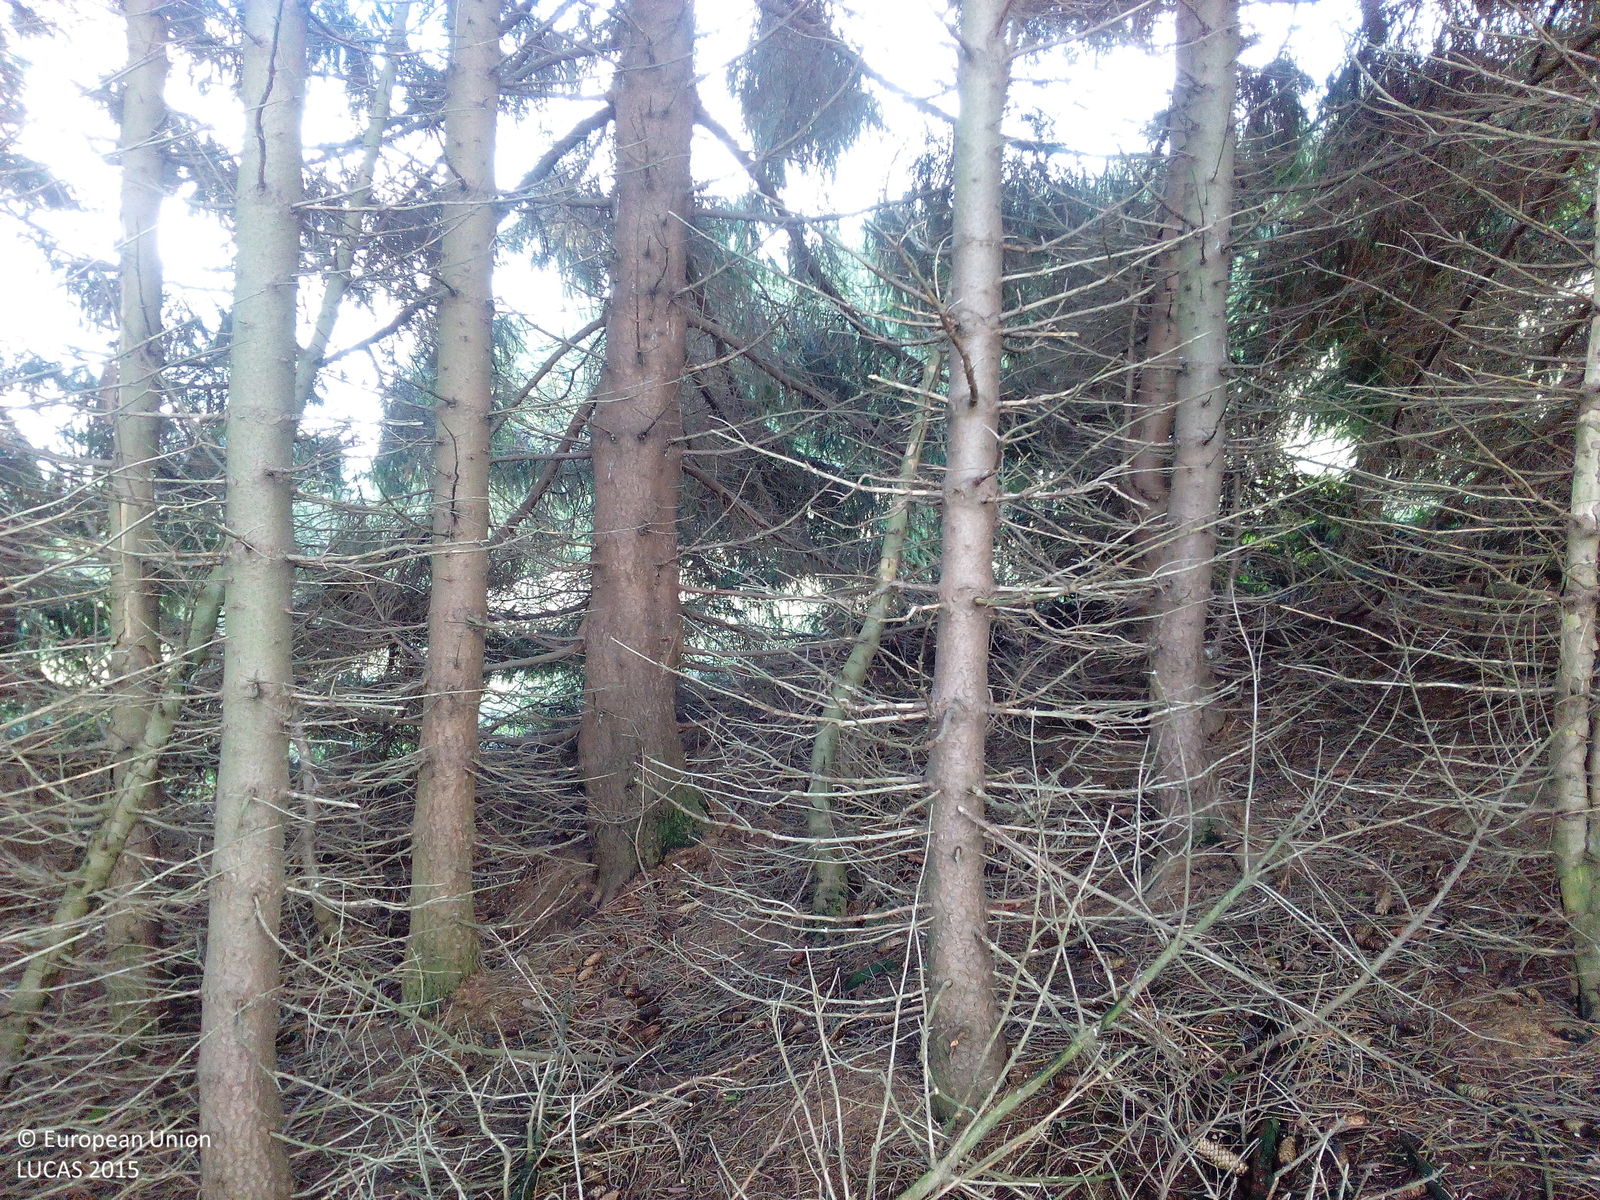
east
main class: Woodland
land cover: Spruce dominated coniferous woodland
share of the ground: > 75 %
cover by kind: coniferous forest trees 80 %, consolidated bare surface 15 %, lichens and mosses 5 %
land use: Forestry
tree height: > 5 m
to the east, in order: Spruce dominated coniferous woodland; Grassland without tree/shrub cover; Spruce dominated coniferous woodland; Grassland without tree/shrub cover; Grassland with sparse tree/shrub cover; Spruce dominated coniferous woodland; Grassland with sparse tree/shrub cover; Spontaneously vegetated surfaces; Grassland without tree/shrub cover; Artificial constructions; Grassland without tree/shrub cover; Spruce dominated coniferous woodland; Grassland without tree/shrub cover
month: October
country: DE
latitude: 50.4000
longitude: 9.9578
